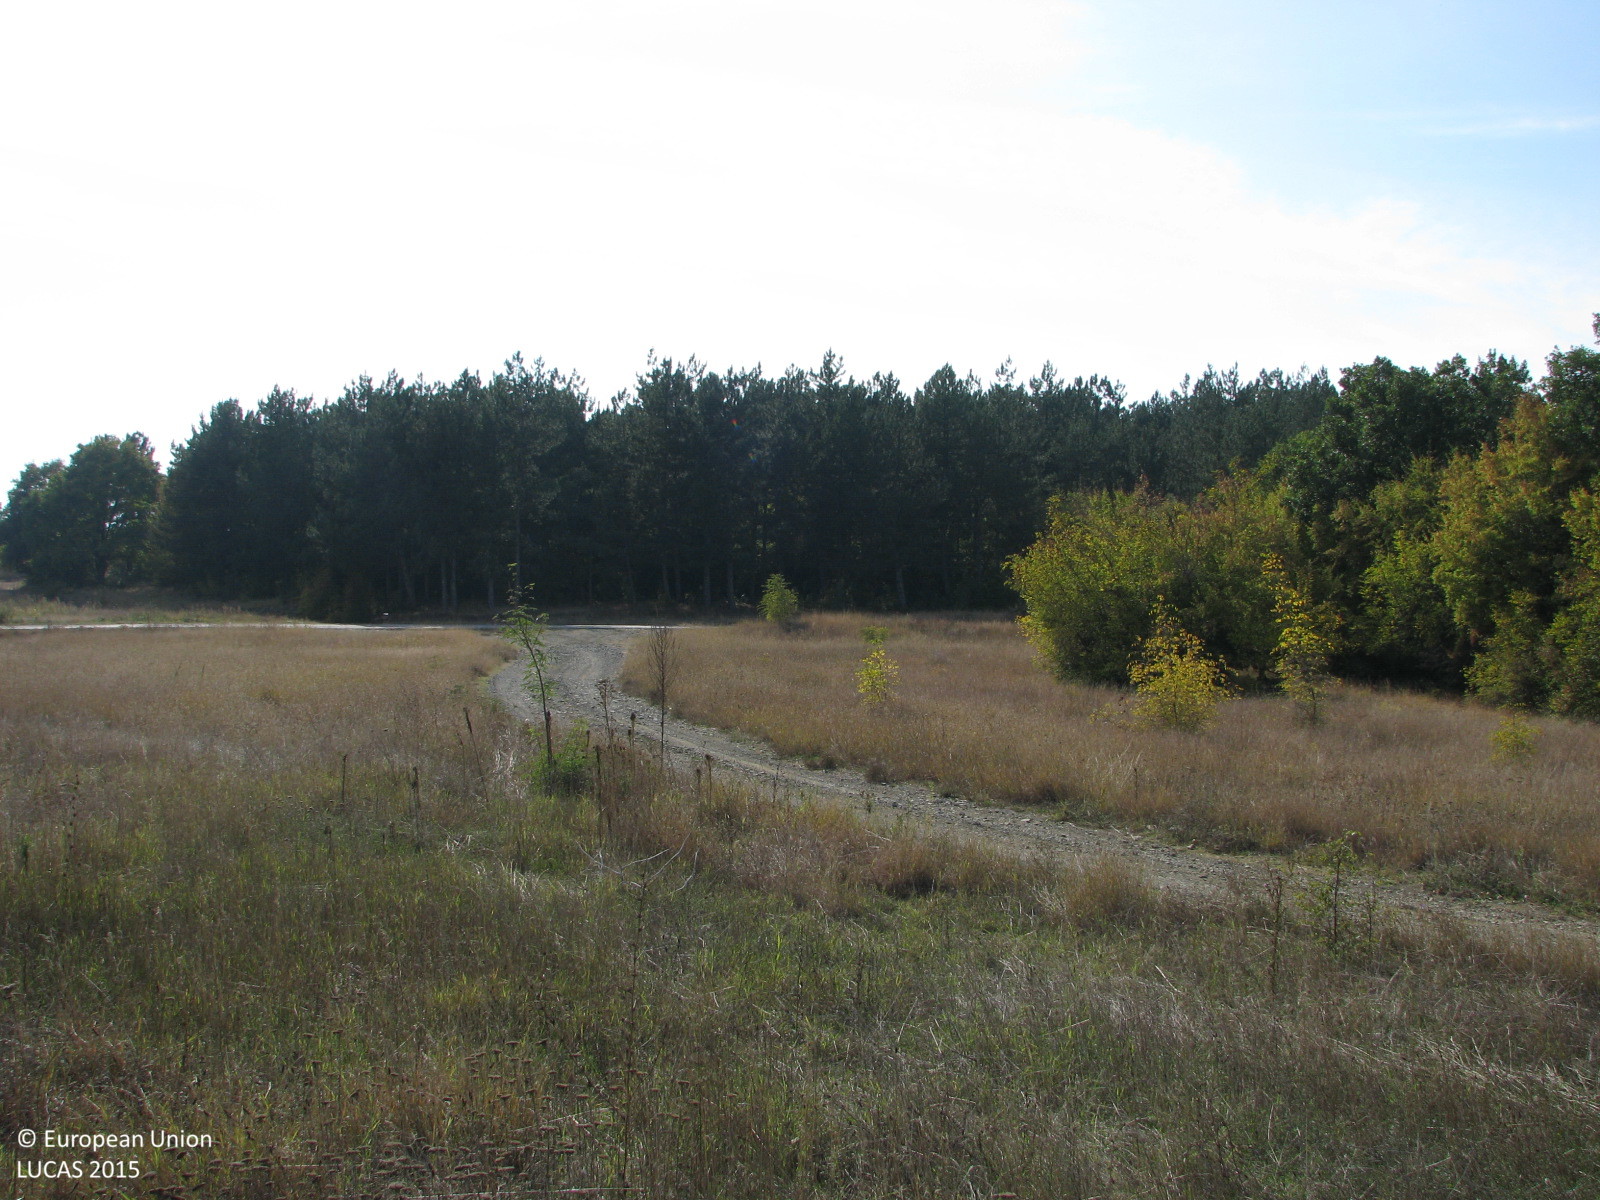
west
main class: Grassland
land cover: Grassland without tree/shrub cover
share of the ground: > 75 %
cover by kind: herbaceous plants 100 %
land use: Agriculture (excluding fallow land and kitchen gardens)
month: October
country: BG
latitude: 42.5287
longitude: 25.8930
